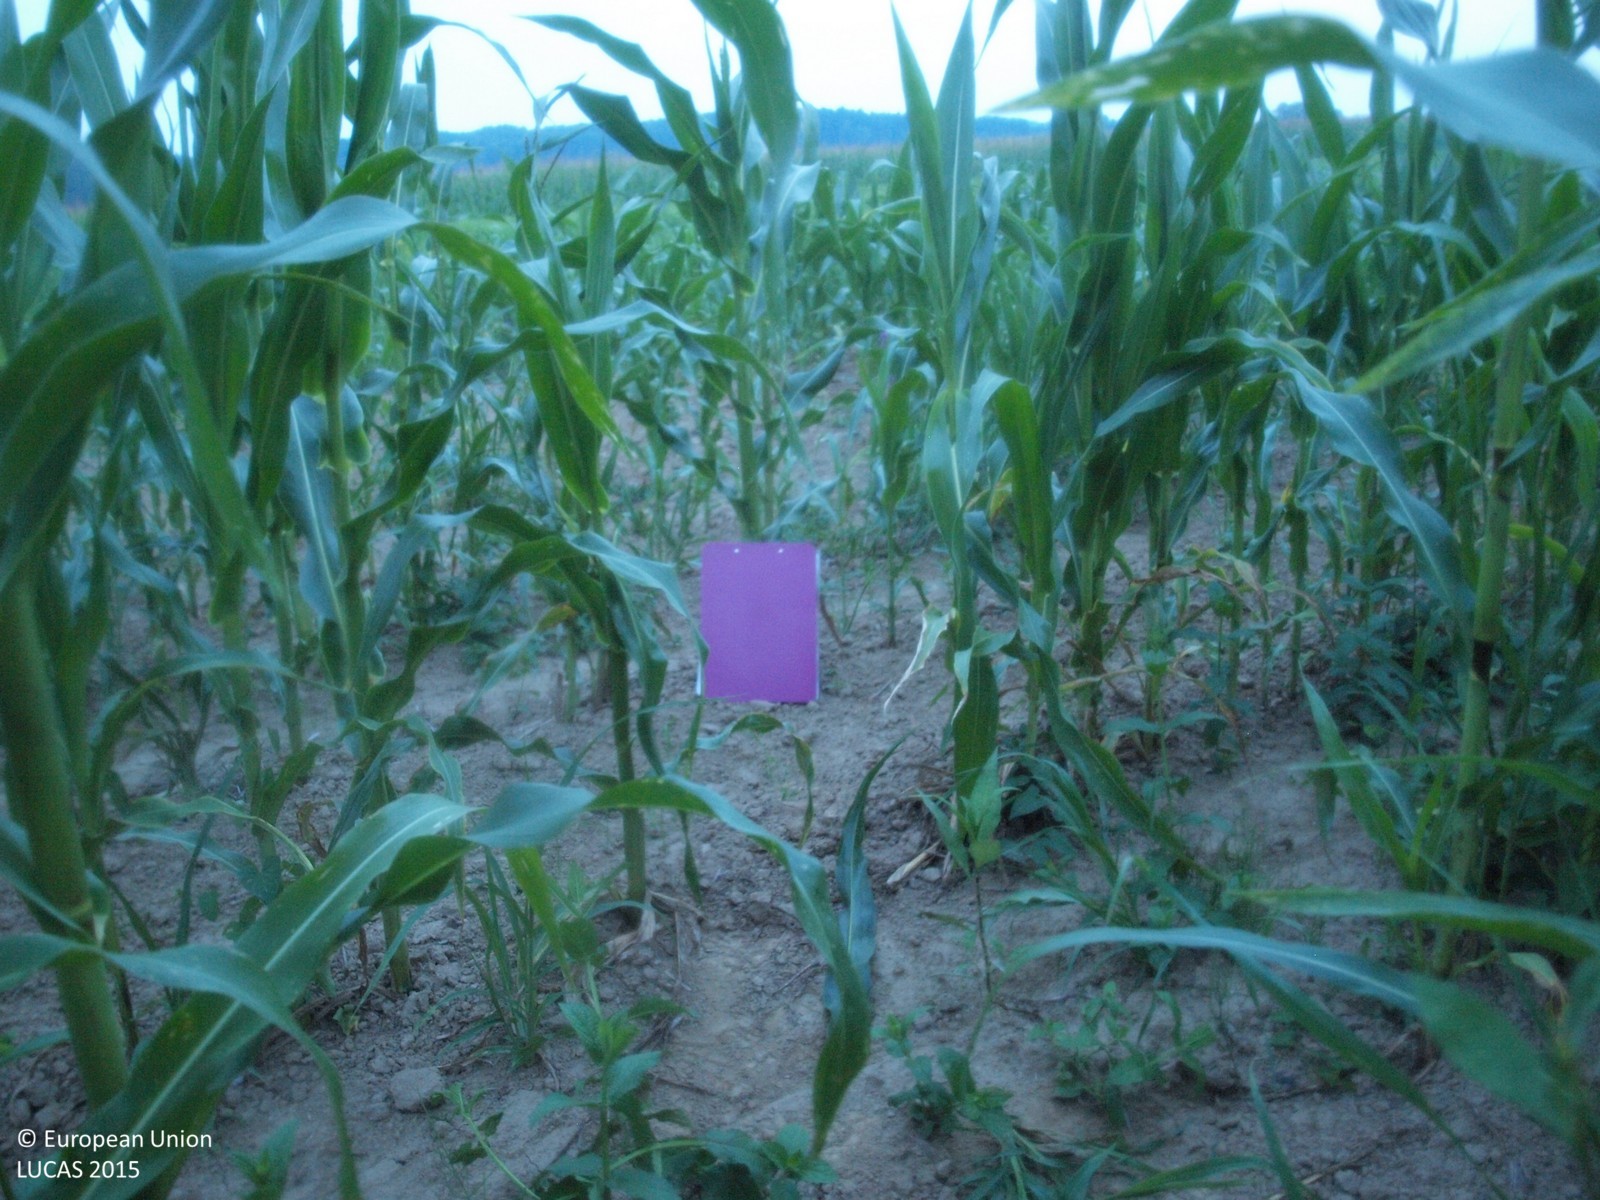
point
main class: Cropland
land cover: Maize
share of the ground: > 75 %
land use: Agriculture (excluding fallow land and kitchen gardens)
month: July
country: HR
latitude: 46.2407
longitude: 16.5498
